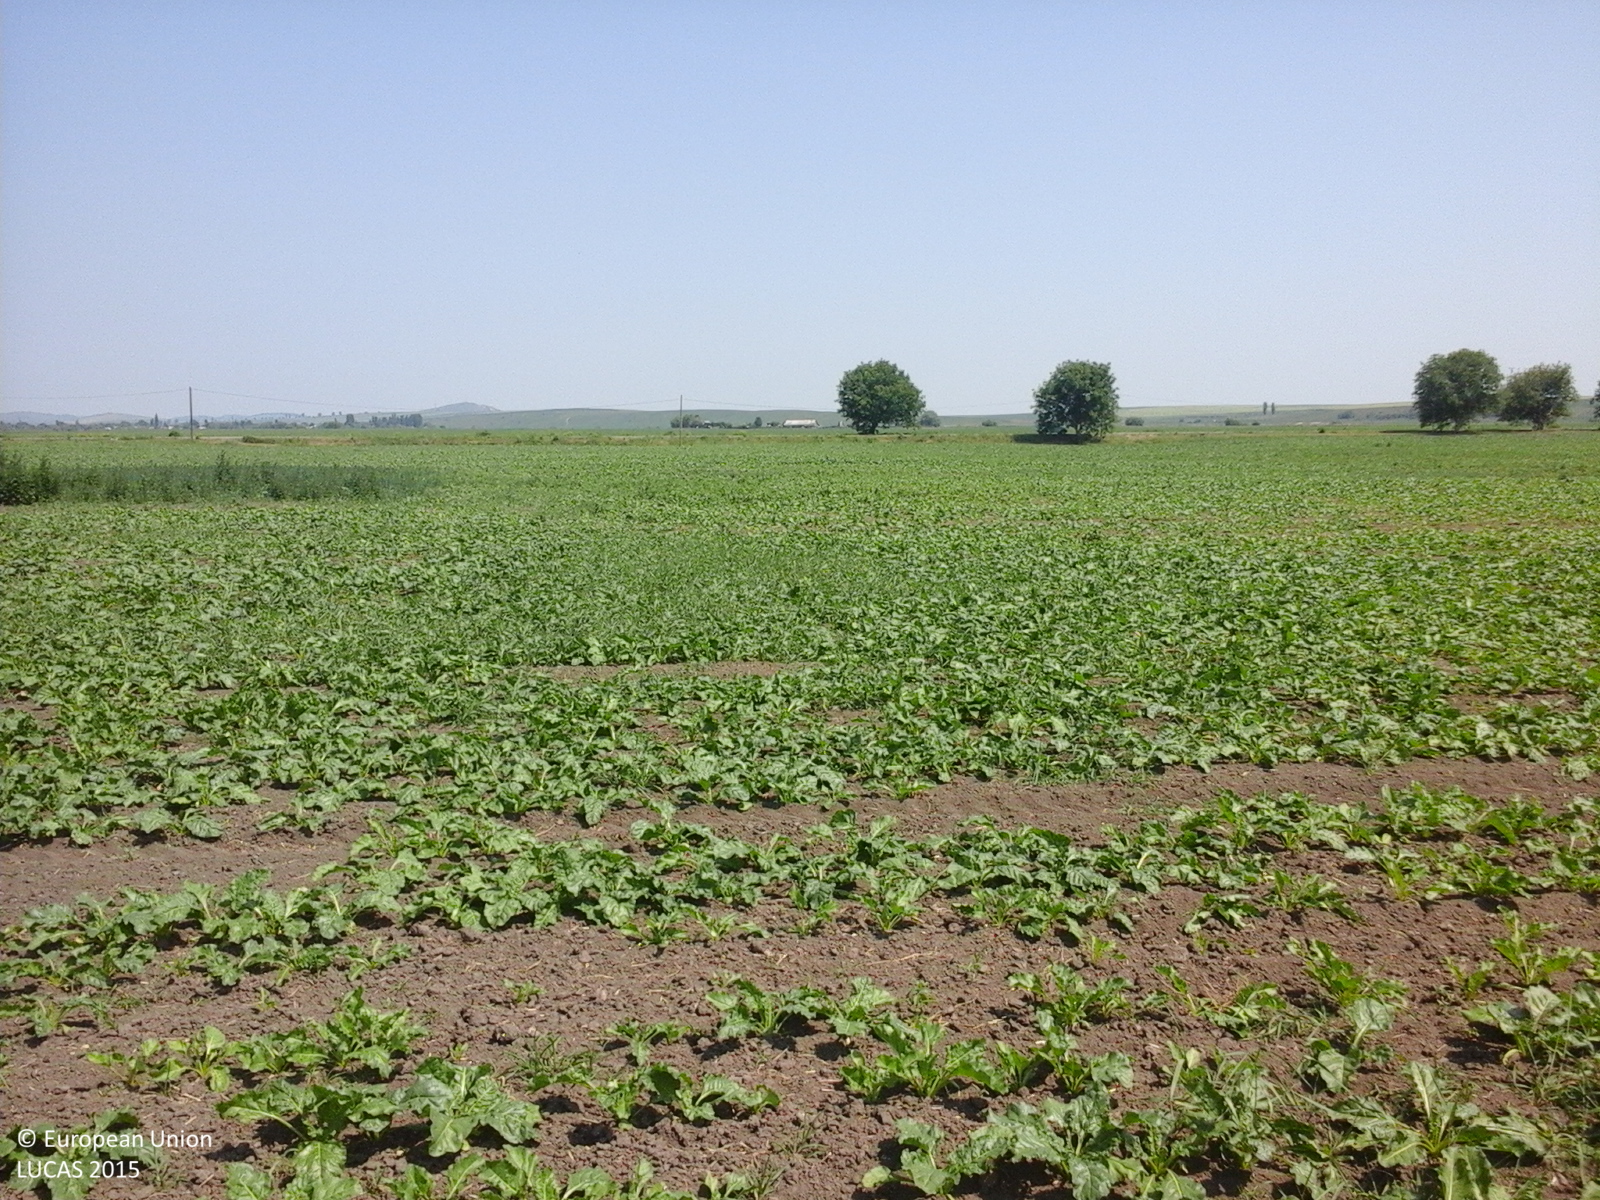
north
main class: Cropland
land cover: Other root crops
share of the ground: 50 - 75 %
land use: Agriculture (excluding fallow land and kitchen gardens)
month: June
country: RO
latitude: 46.8905
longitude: 26.5305
